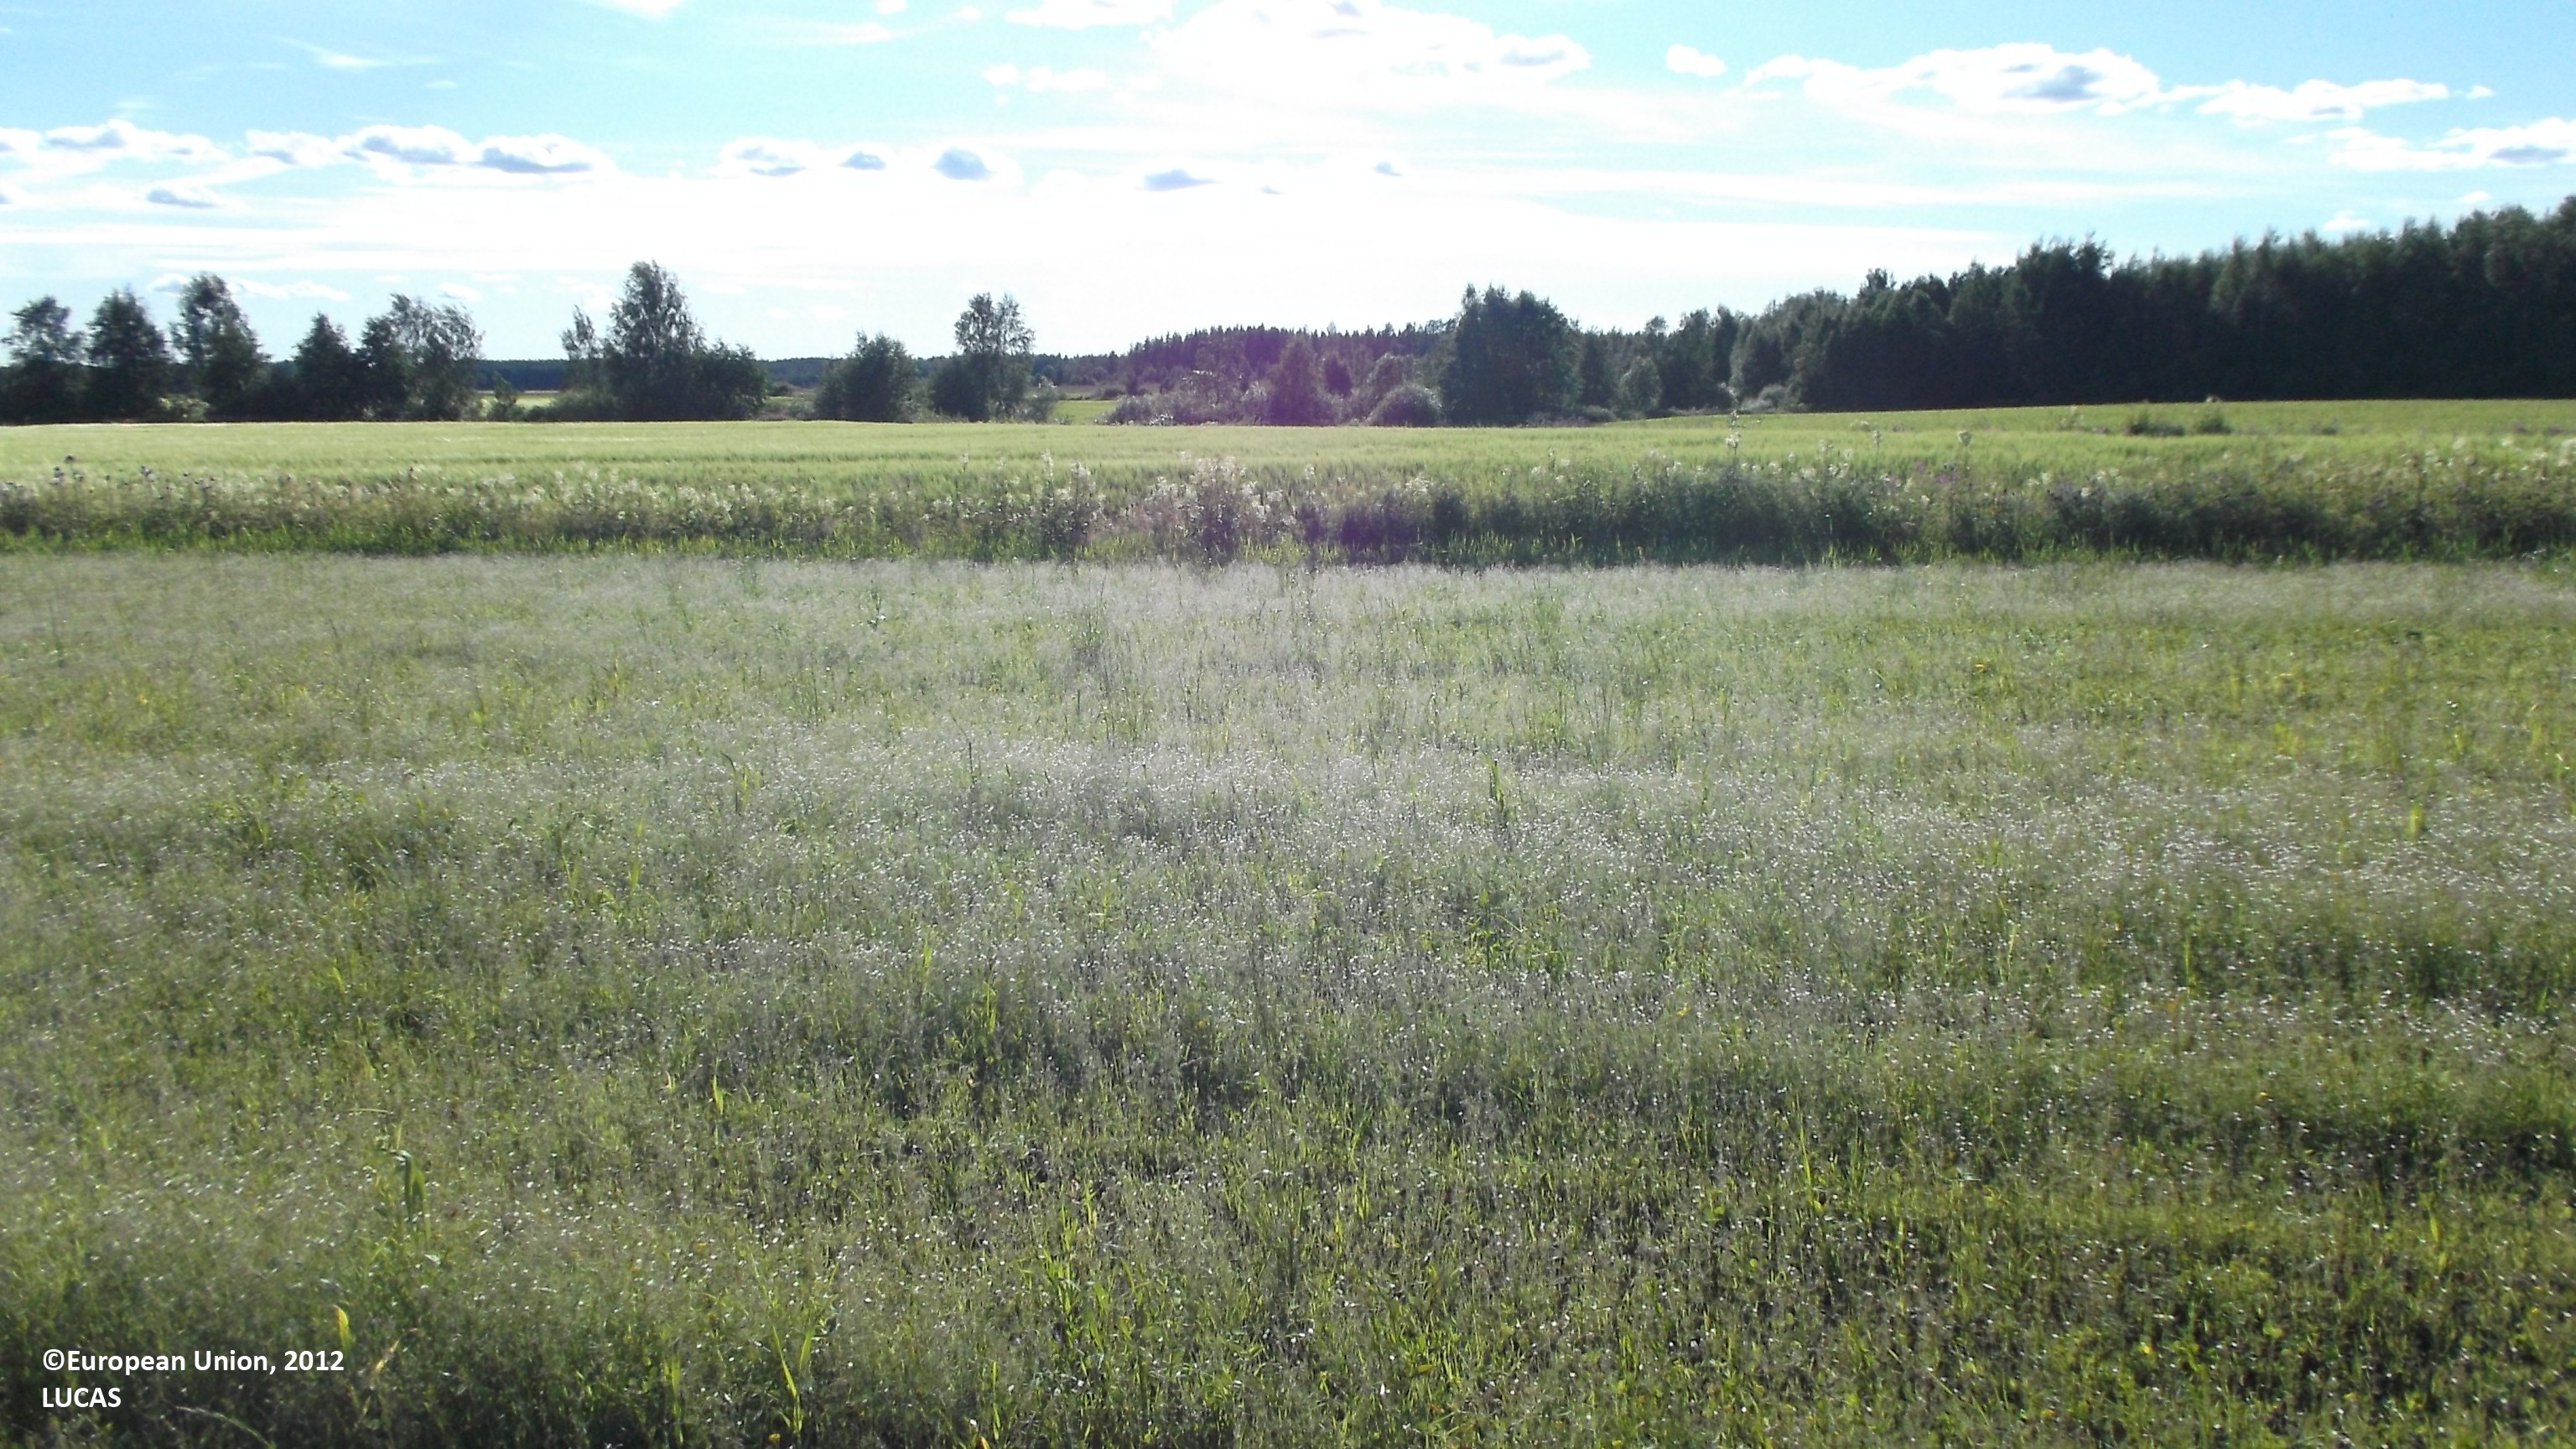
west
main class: Cropland
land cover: Other non-permanent industrial crops
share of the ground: < 10 %
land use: Agriculture (excluding fallow land and kitchen gardens)
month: July
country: FI
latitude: 63.2413
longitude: 23.7859
